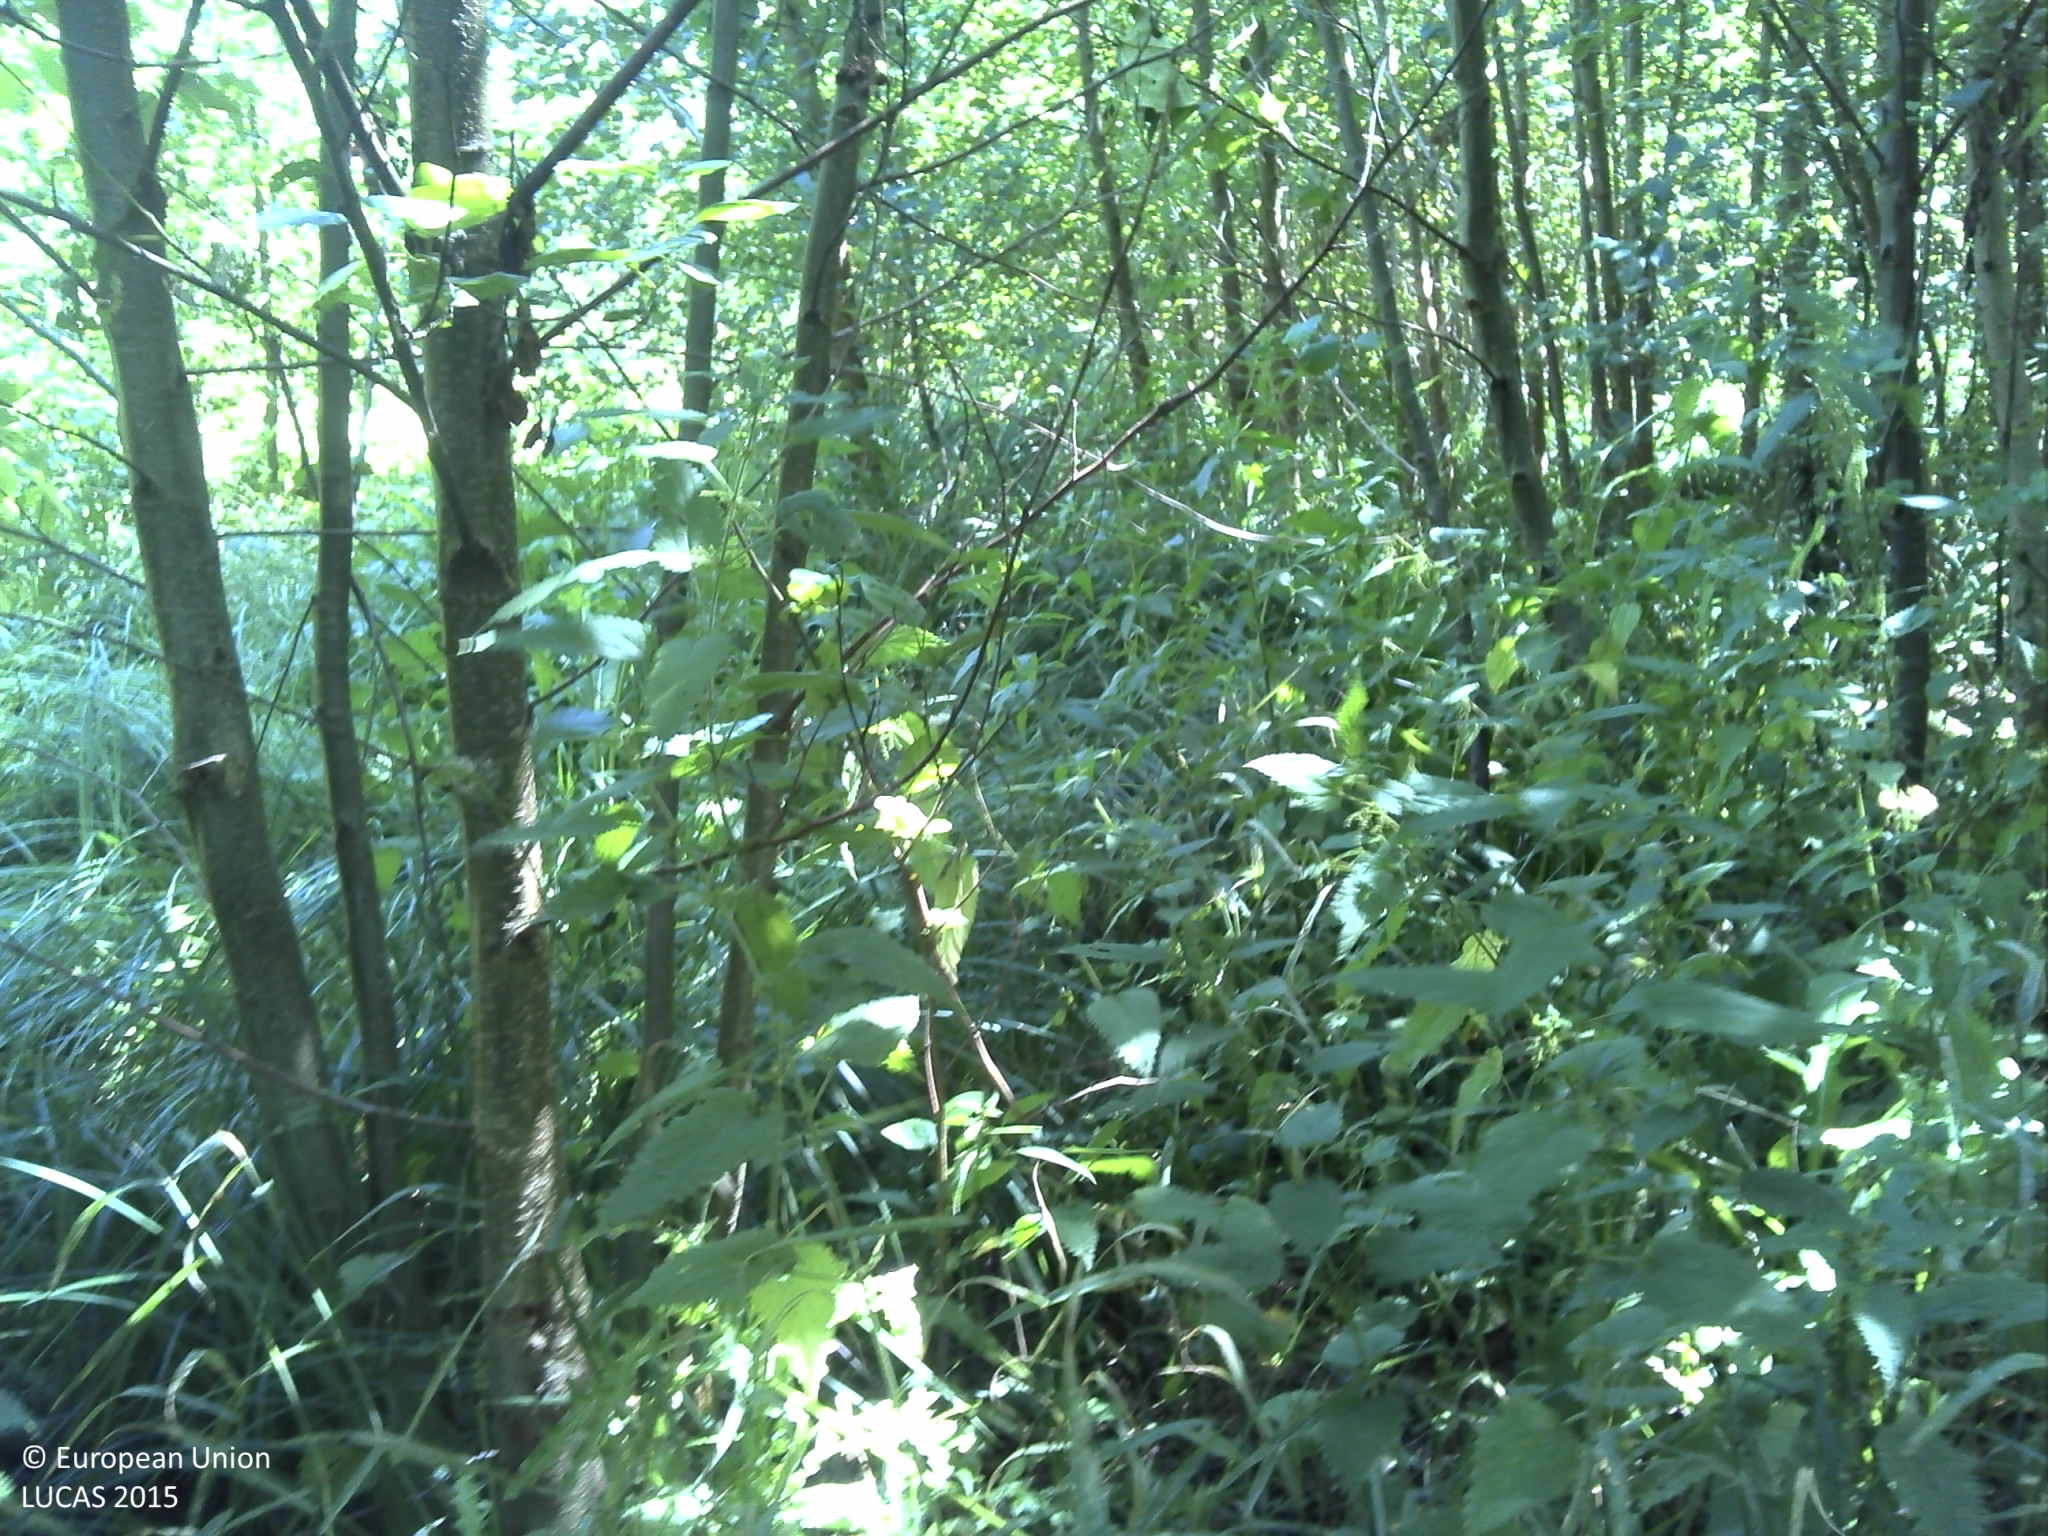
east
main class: Woodland
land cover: Broadleaved woodland
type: floodplain forest
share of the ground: > 75 %
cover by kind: broadleaved forest trees 70 %, herbaceous plants 20 %, shrubs 10 %
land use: Forestry
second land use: Amenities, museums, leisure
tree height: > 5 m
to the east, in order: Broadleaved woodland; Tracks; Broadleaved woodland
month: July
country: FR
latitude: 48.5260
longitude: 1.9566
